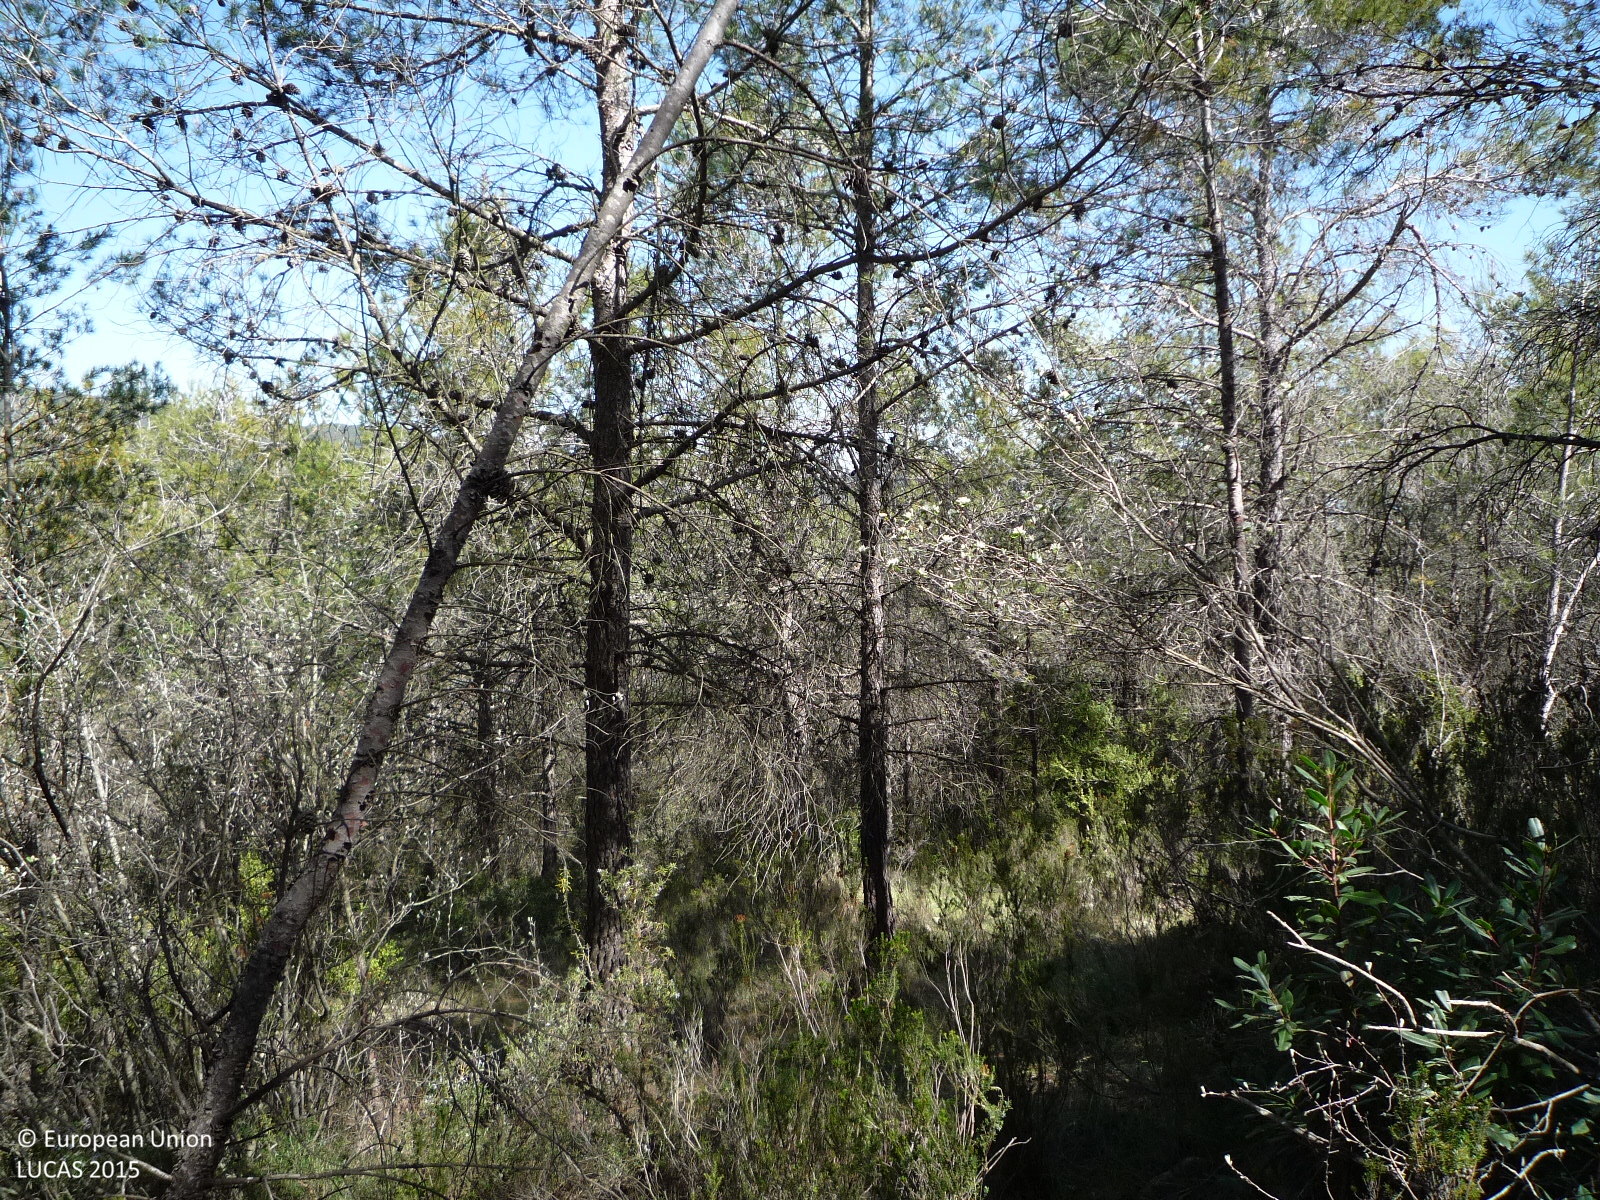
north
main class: Woodland
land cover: Pine dominated coniferous woodland
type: coniferous forest of the mediterranean region
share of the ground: > 75 %
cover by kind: coniferous forest trees 75 %, shrubs 15 %, herbaceous plants 10 %
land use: Semi-natural and natural areas not in use
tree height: > 5 m
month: April
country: ES
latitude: 41.4494
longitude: 1.5774
